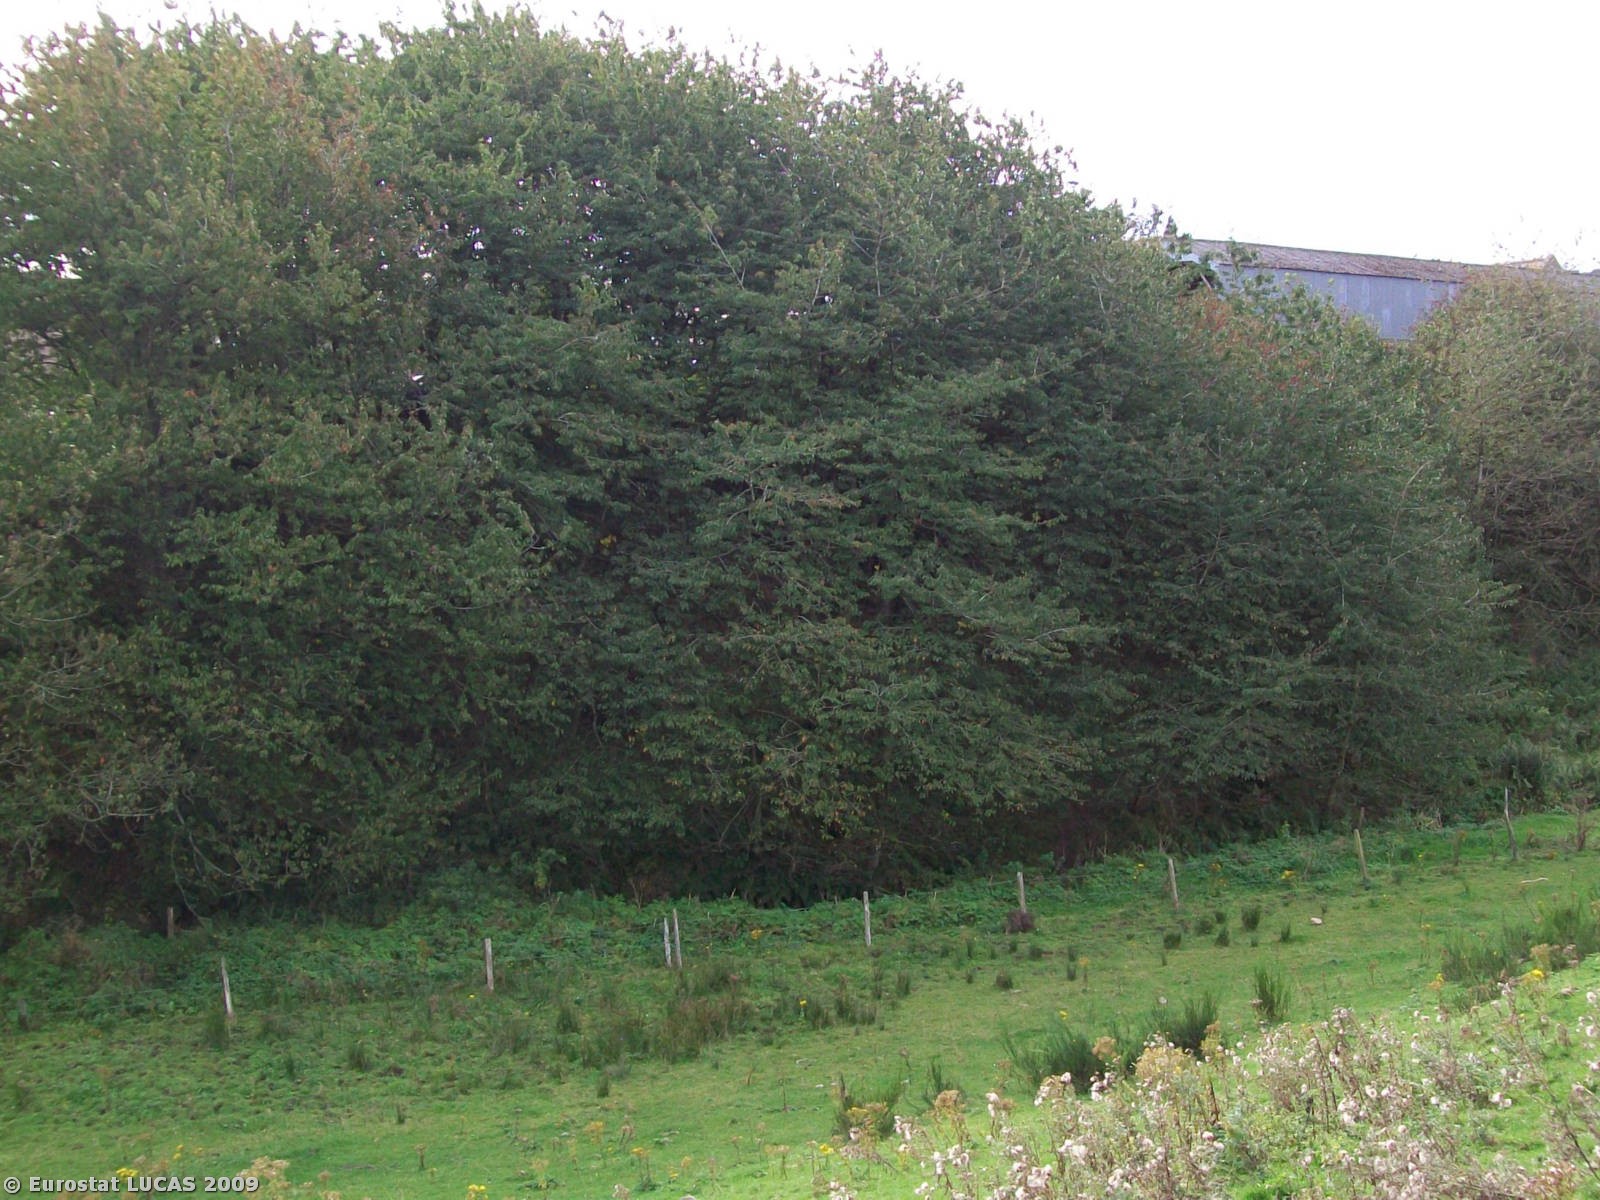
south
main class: Grassland
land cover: Grassland without tree/shrub cover
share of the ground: > 75 %
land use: Agriculture (excluding fallow land and kitchen gardens)
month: September
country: GB
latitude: 57.2708
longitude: -2.4744
